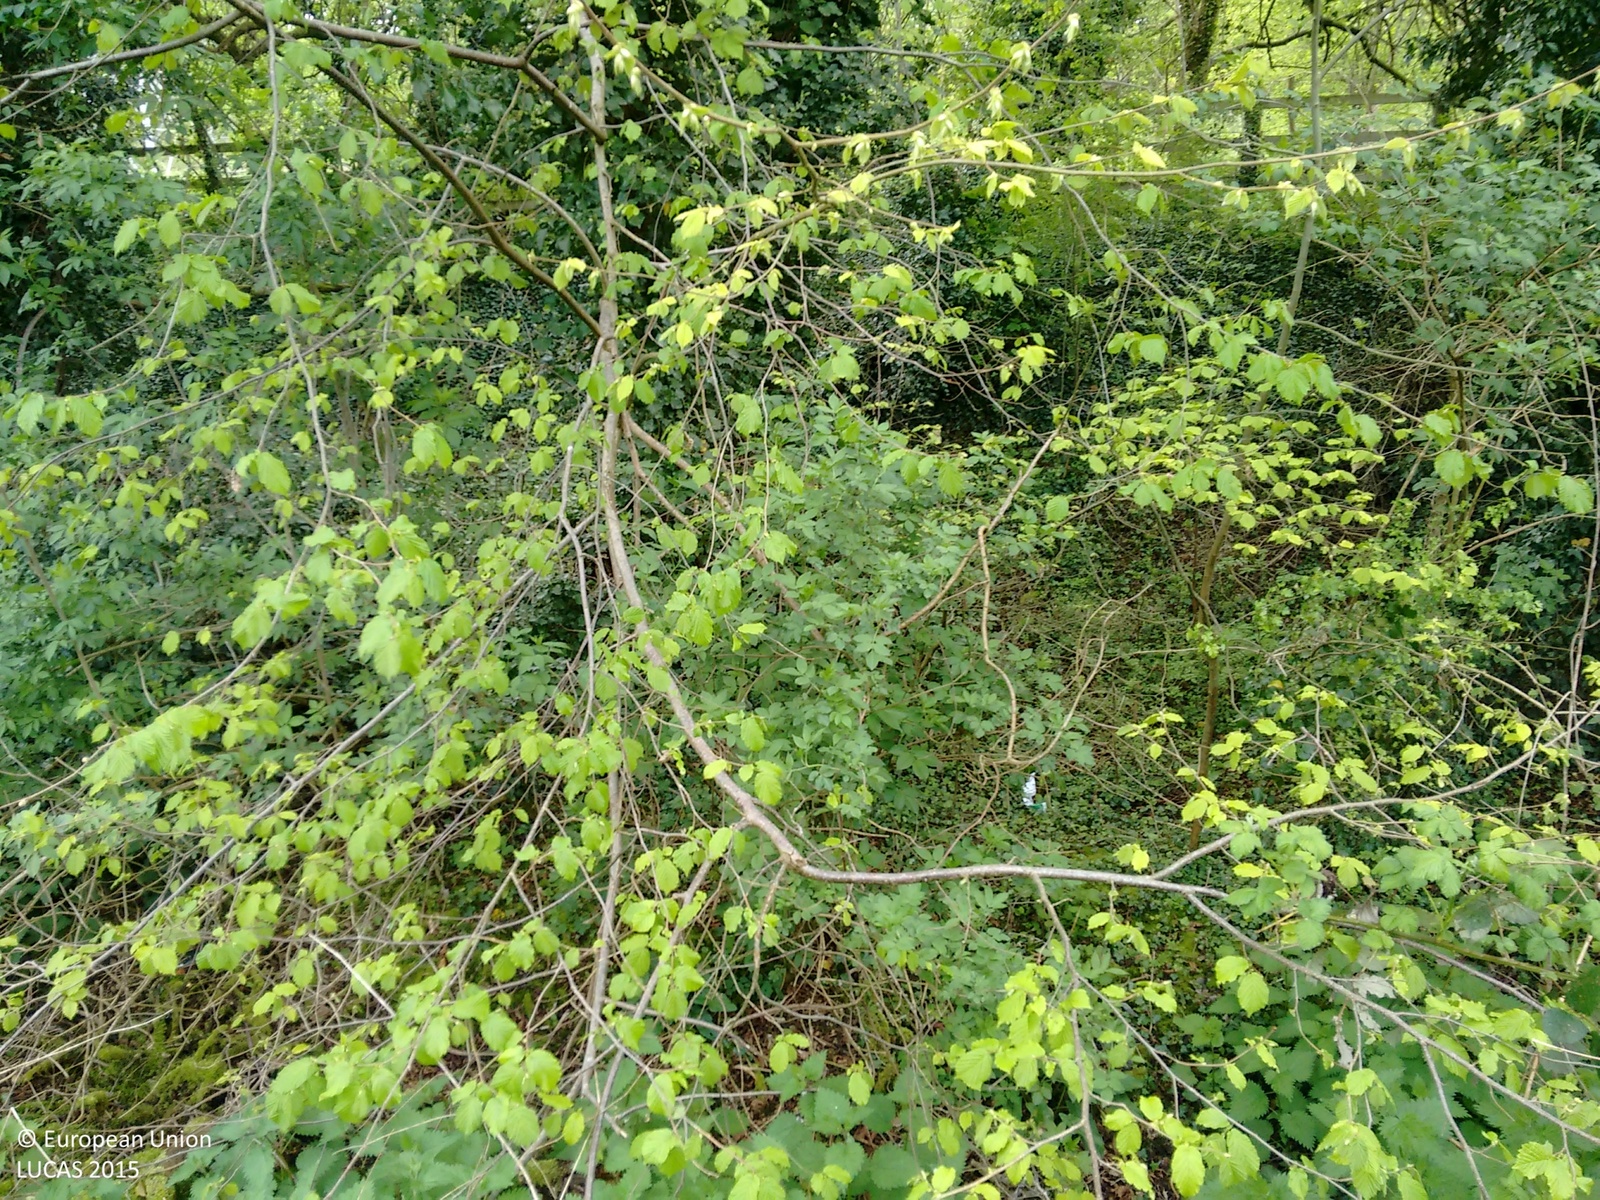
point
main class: Woodland
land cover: Broadleaved woodland
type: mesophytic deciduous forest
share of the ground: > 75 %
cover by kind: broadleaved forest trees 100 %
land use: Amenities, museums, leisure
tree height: > 5 m
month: May
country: GB
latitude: 51.2179
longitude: -1.4903
